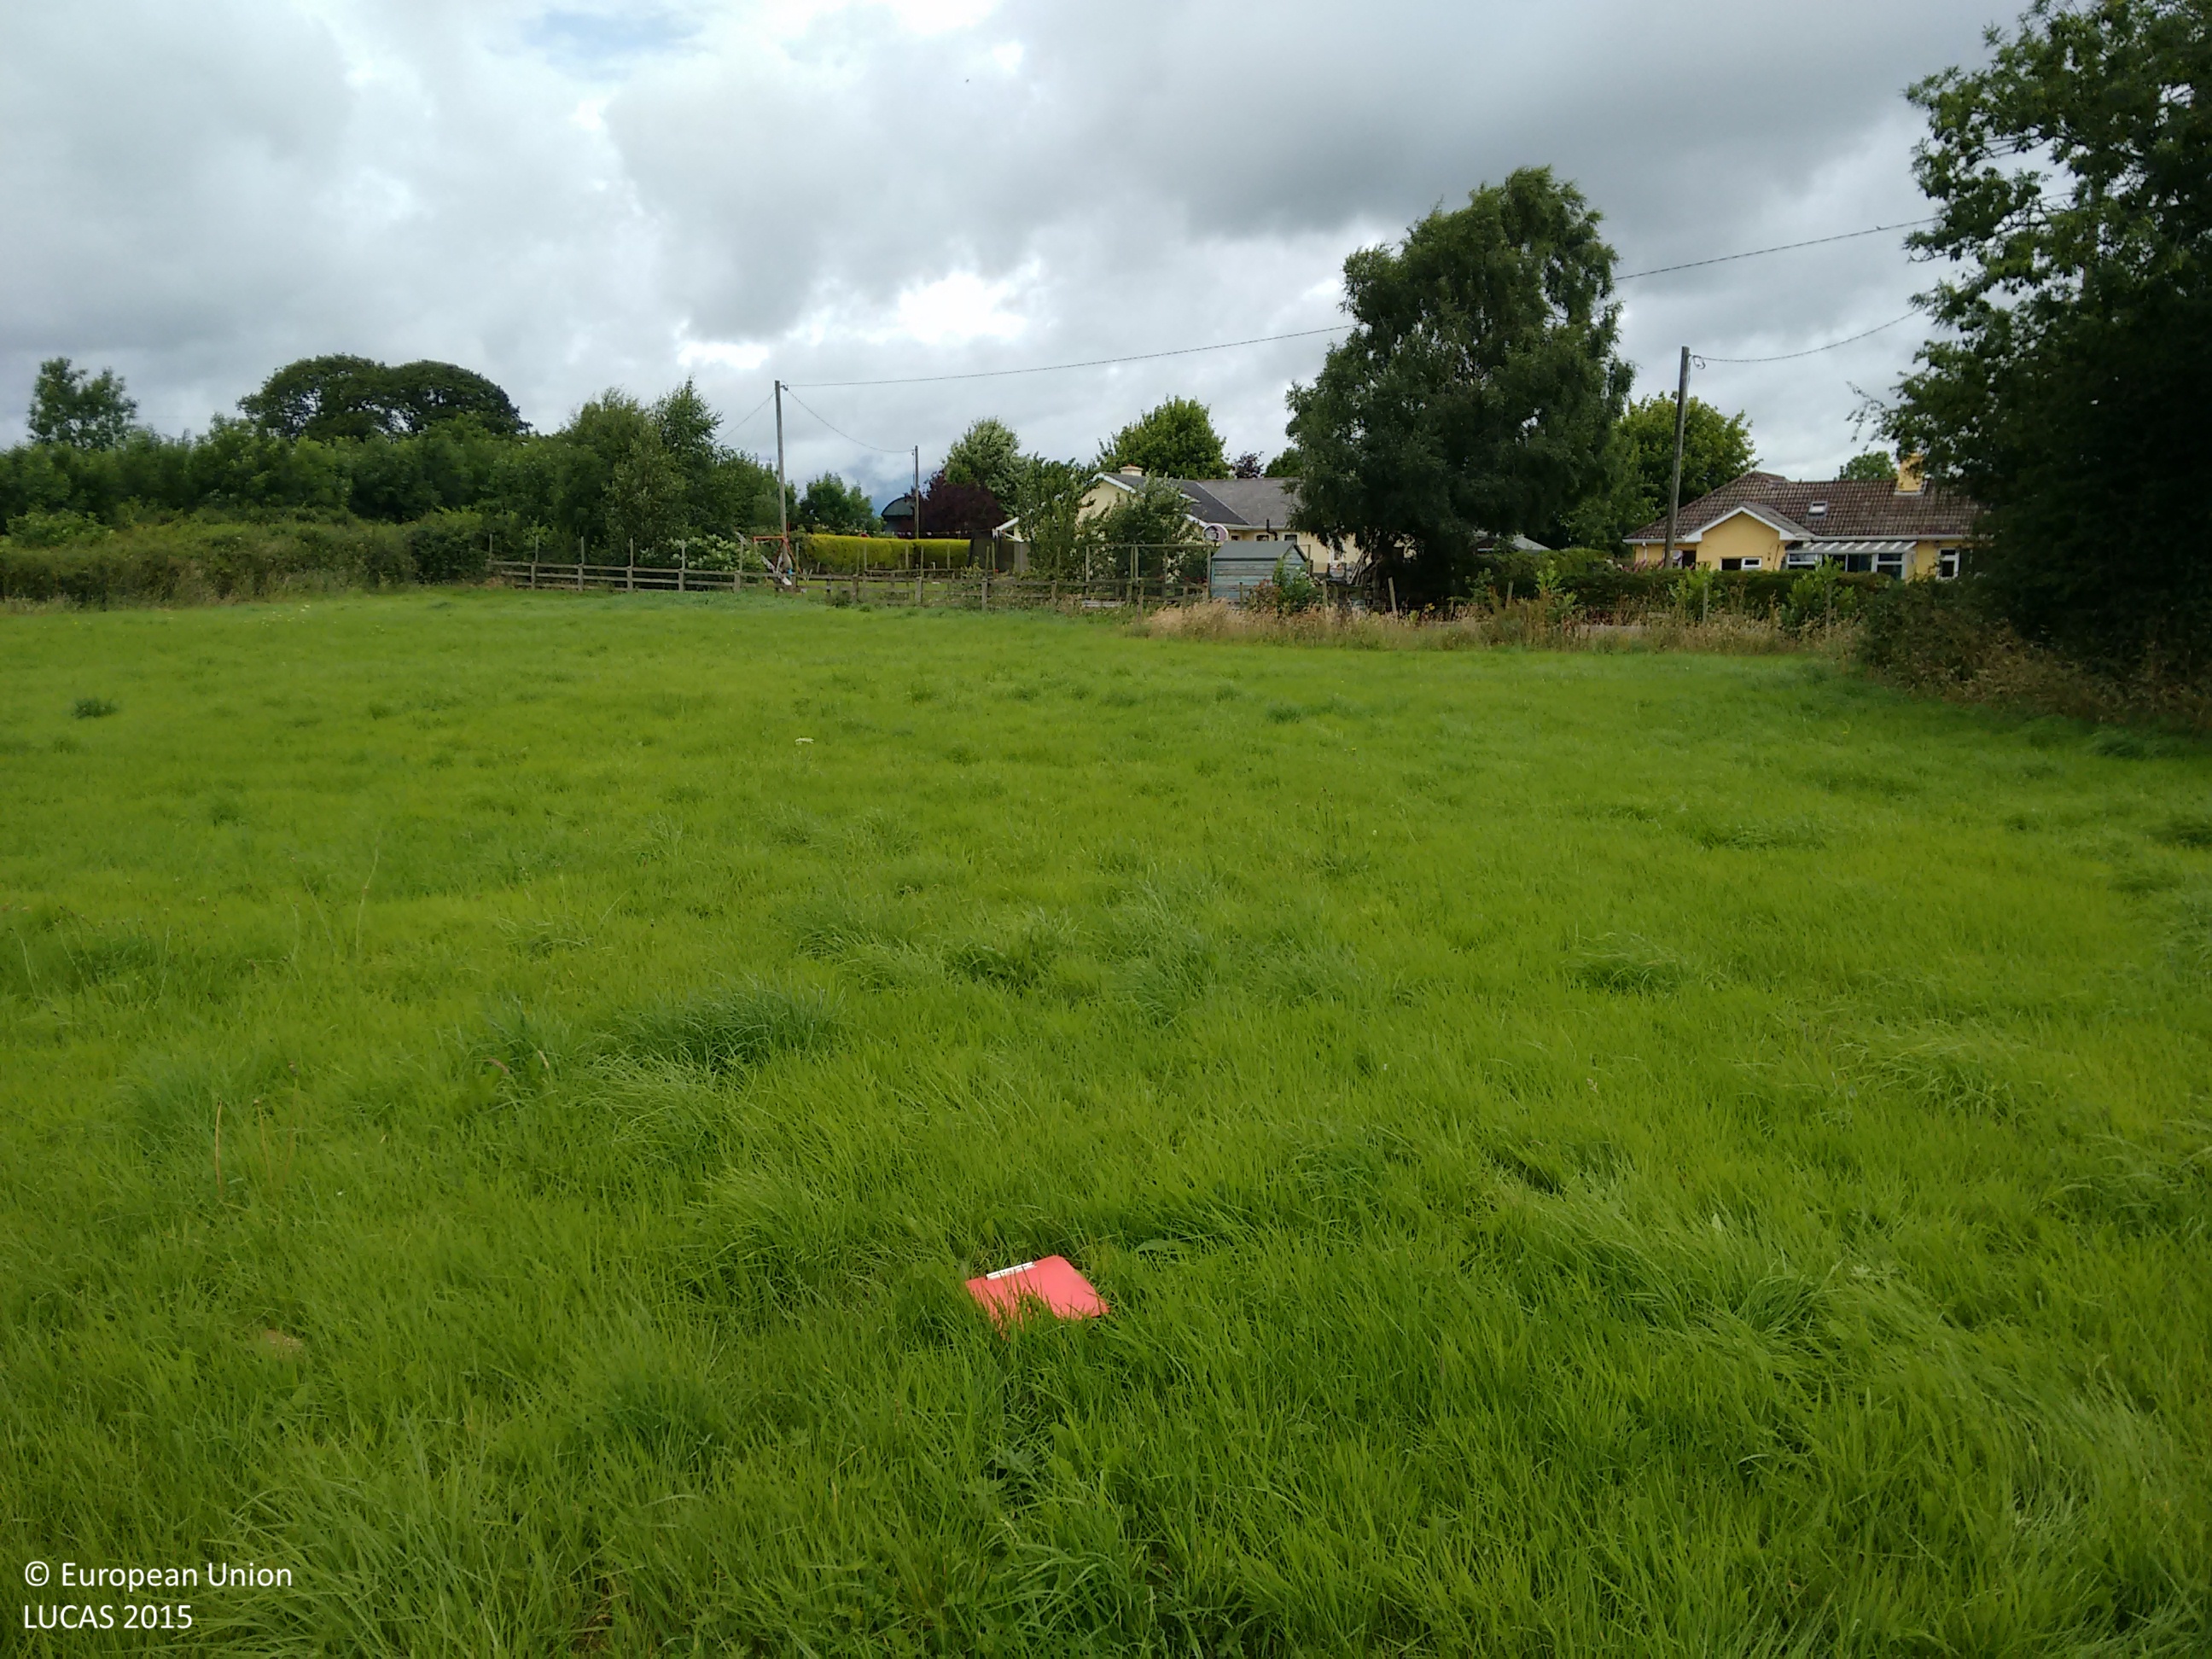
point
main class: Grassland
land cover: Grassland without tree/shrub cover
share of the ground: > 75 %
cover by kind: herbaceous plants 100 %
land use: Agriculture (excluding fallow land and kitchen gardens)
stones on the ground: < 10 %
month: July
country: IE
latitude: 52.5994
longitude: -7.3239
